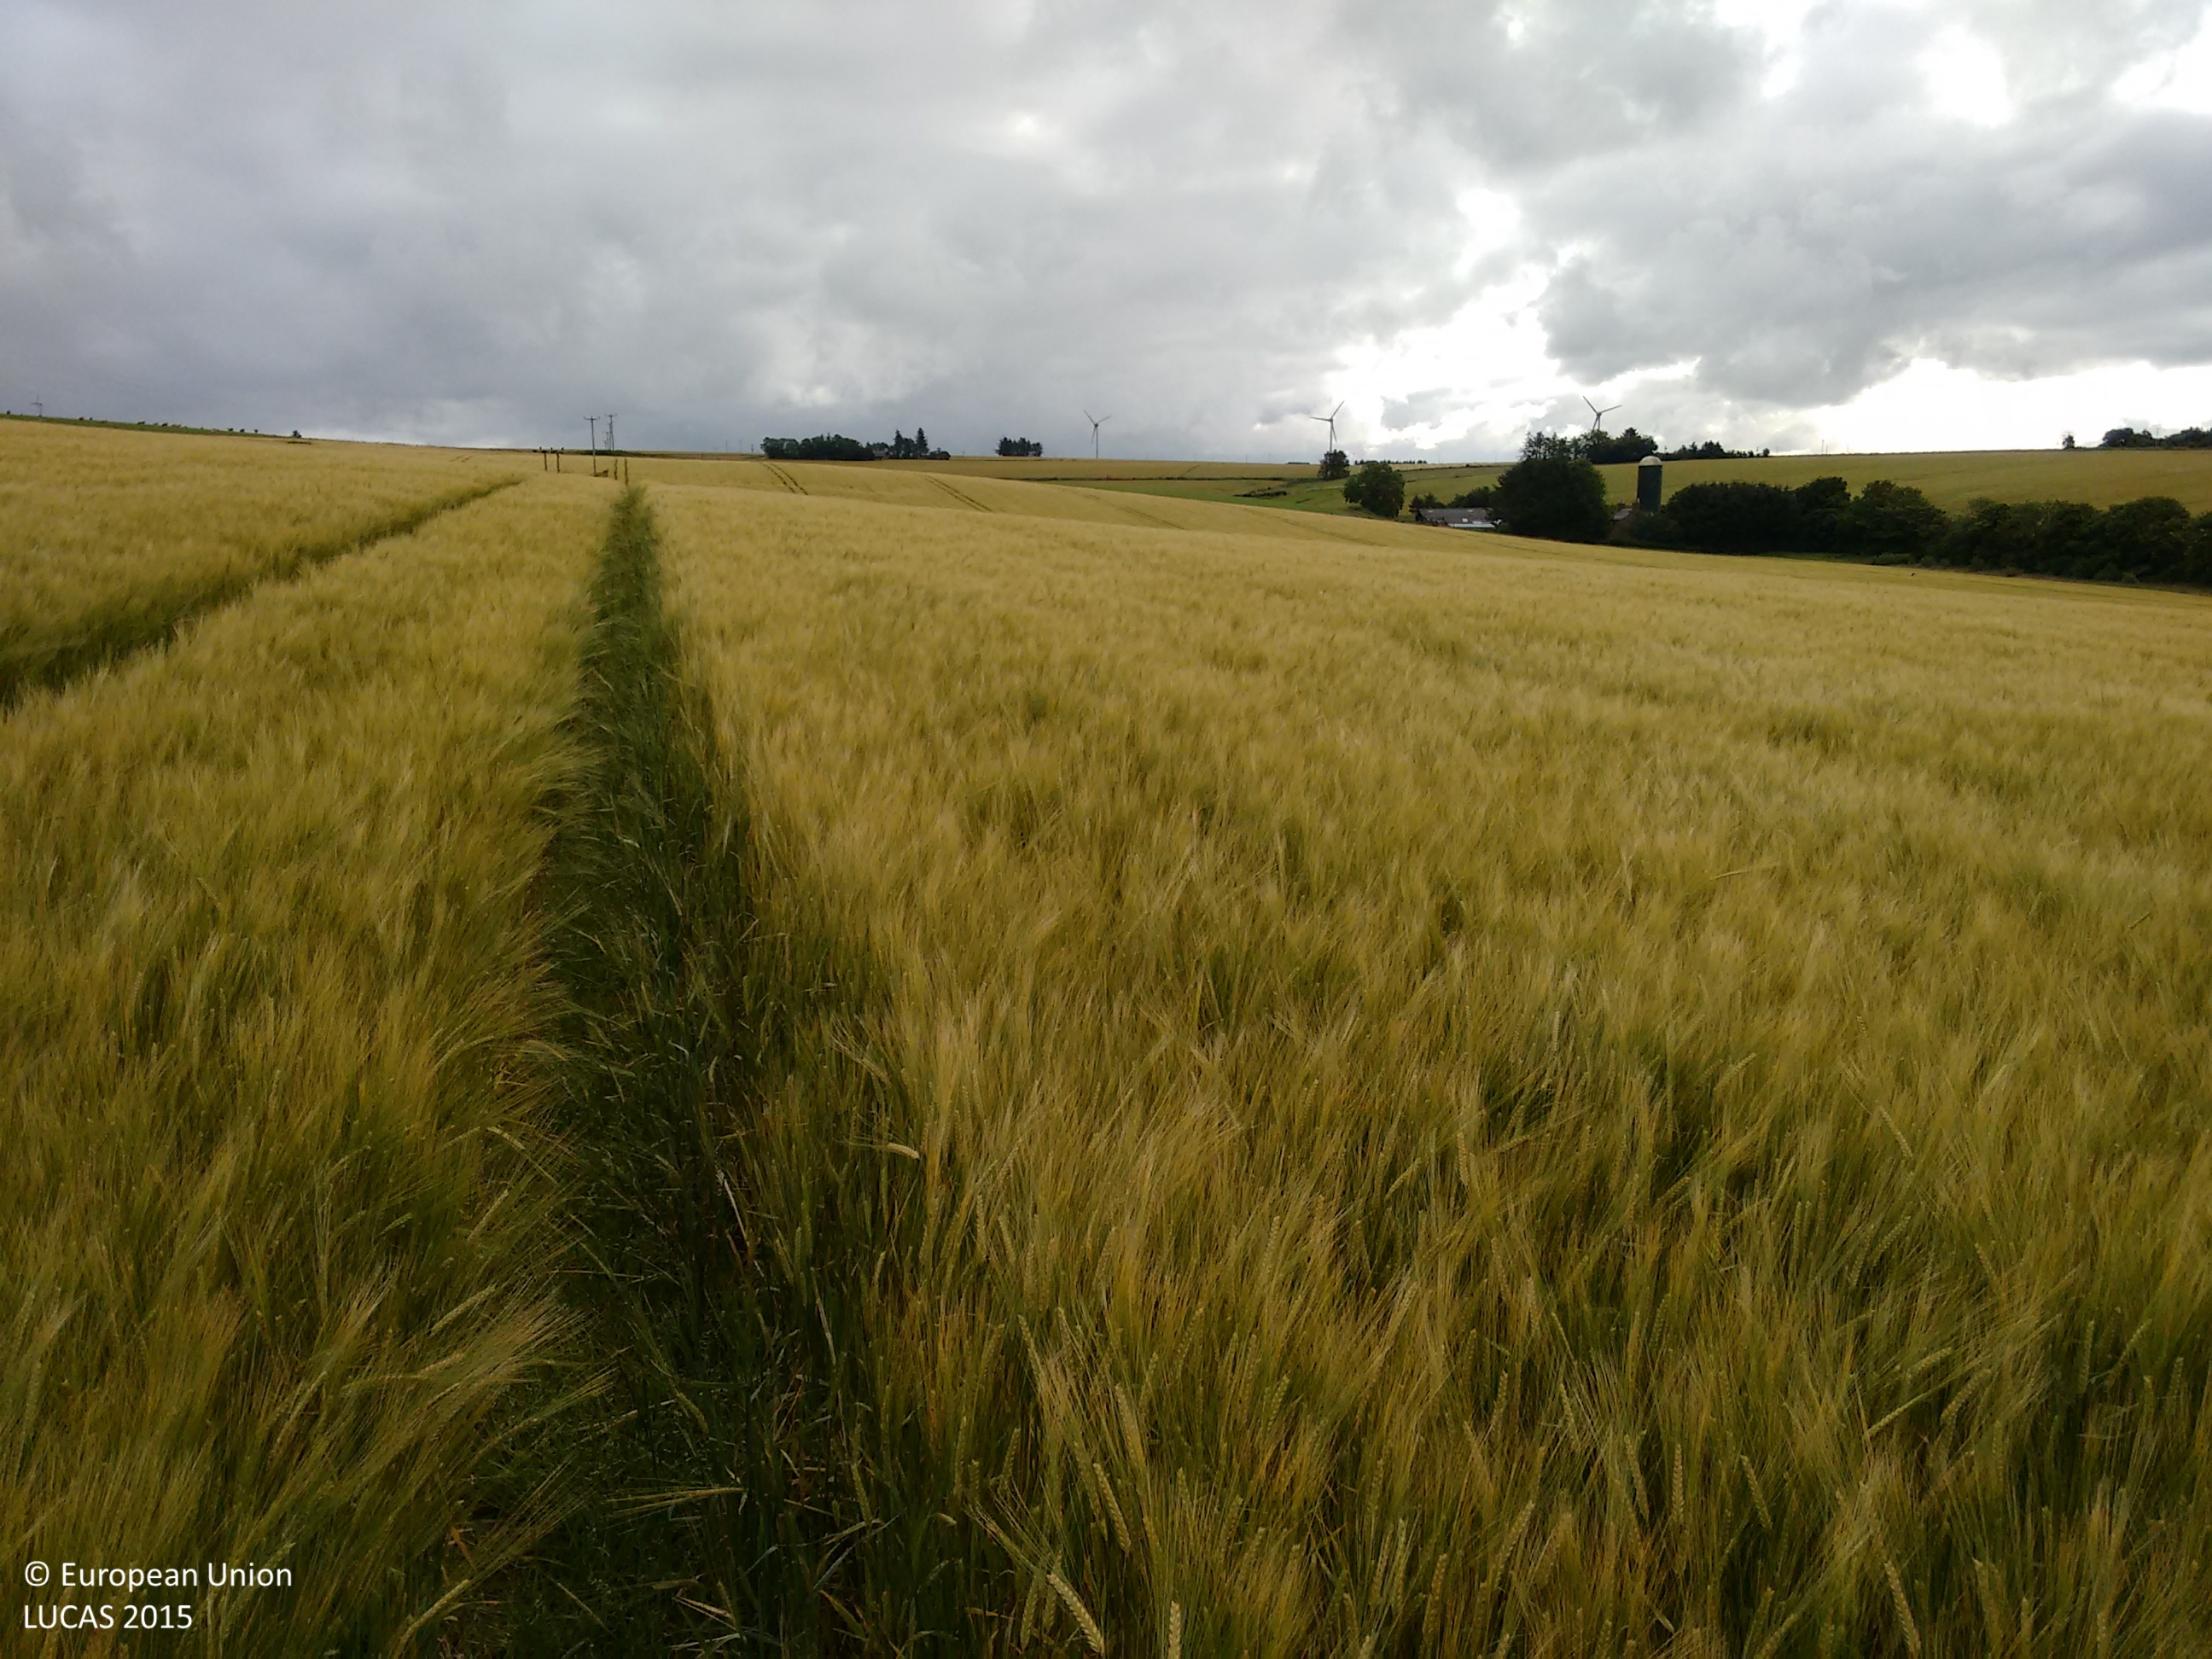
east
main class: Cropland
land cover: Barley
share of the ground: > 75 %
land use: Agriculture (excluding fallow land and kitchen gardens)
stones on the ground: 10 - 25 %
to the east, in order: Barley
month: July
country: GB
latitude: 57.5513
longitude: -2.4001
